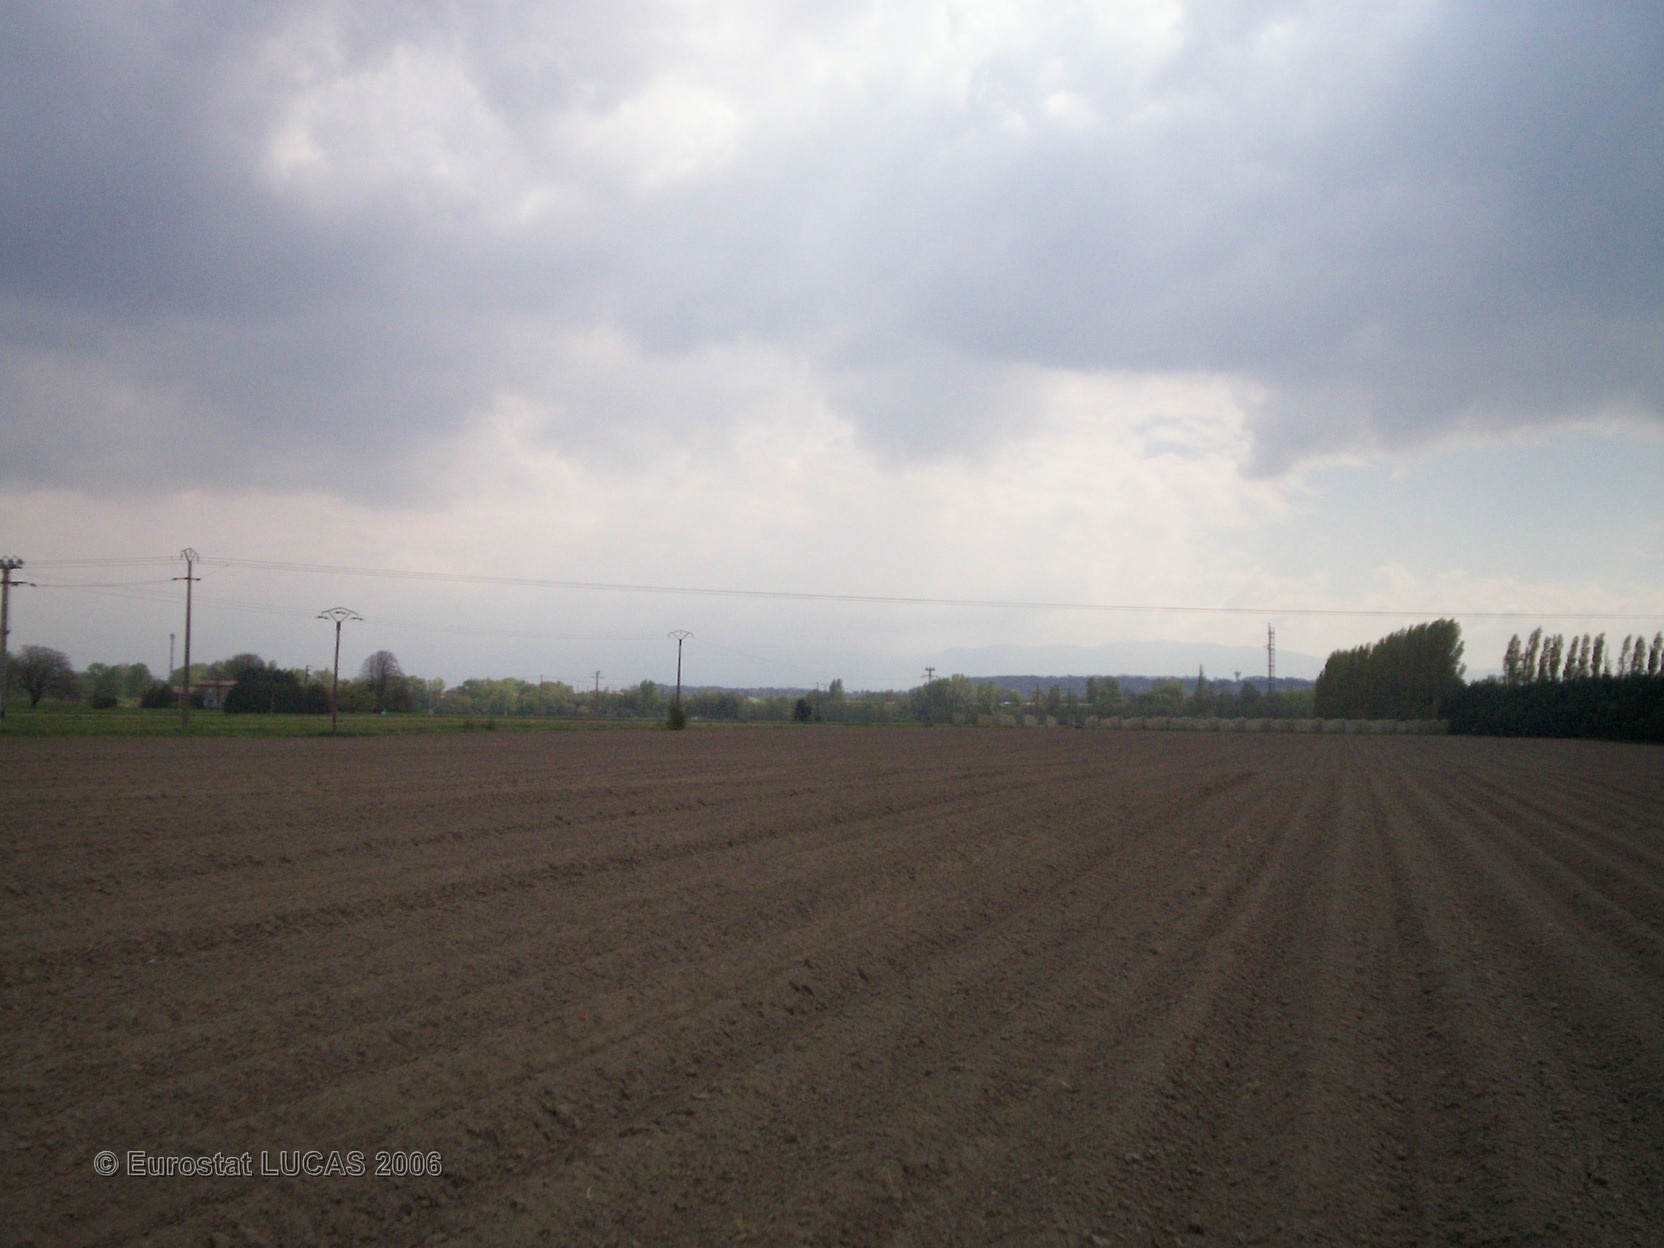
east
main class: Cropland
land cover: Potatoes
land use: Agriculture (excluding fallow land and kitchen gardens)
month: June
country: FR
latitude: 44.8553
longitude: 4.8557
